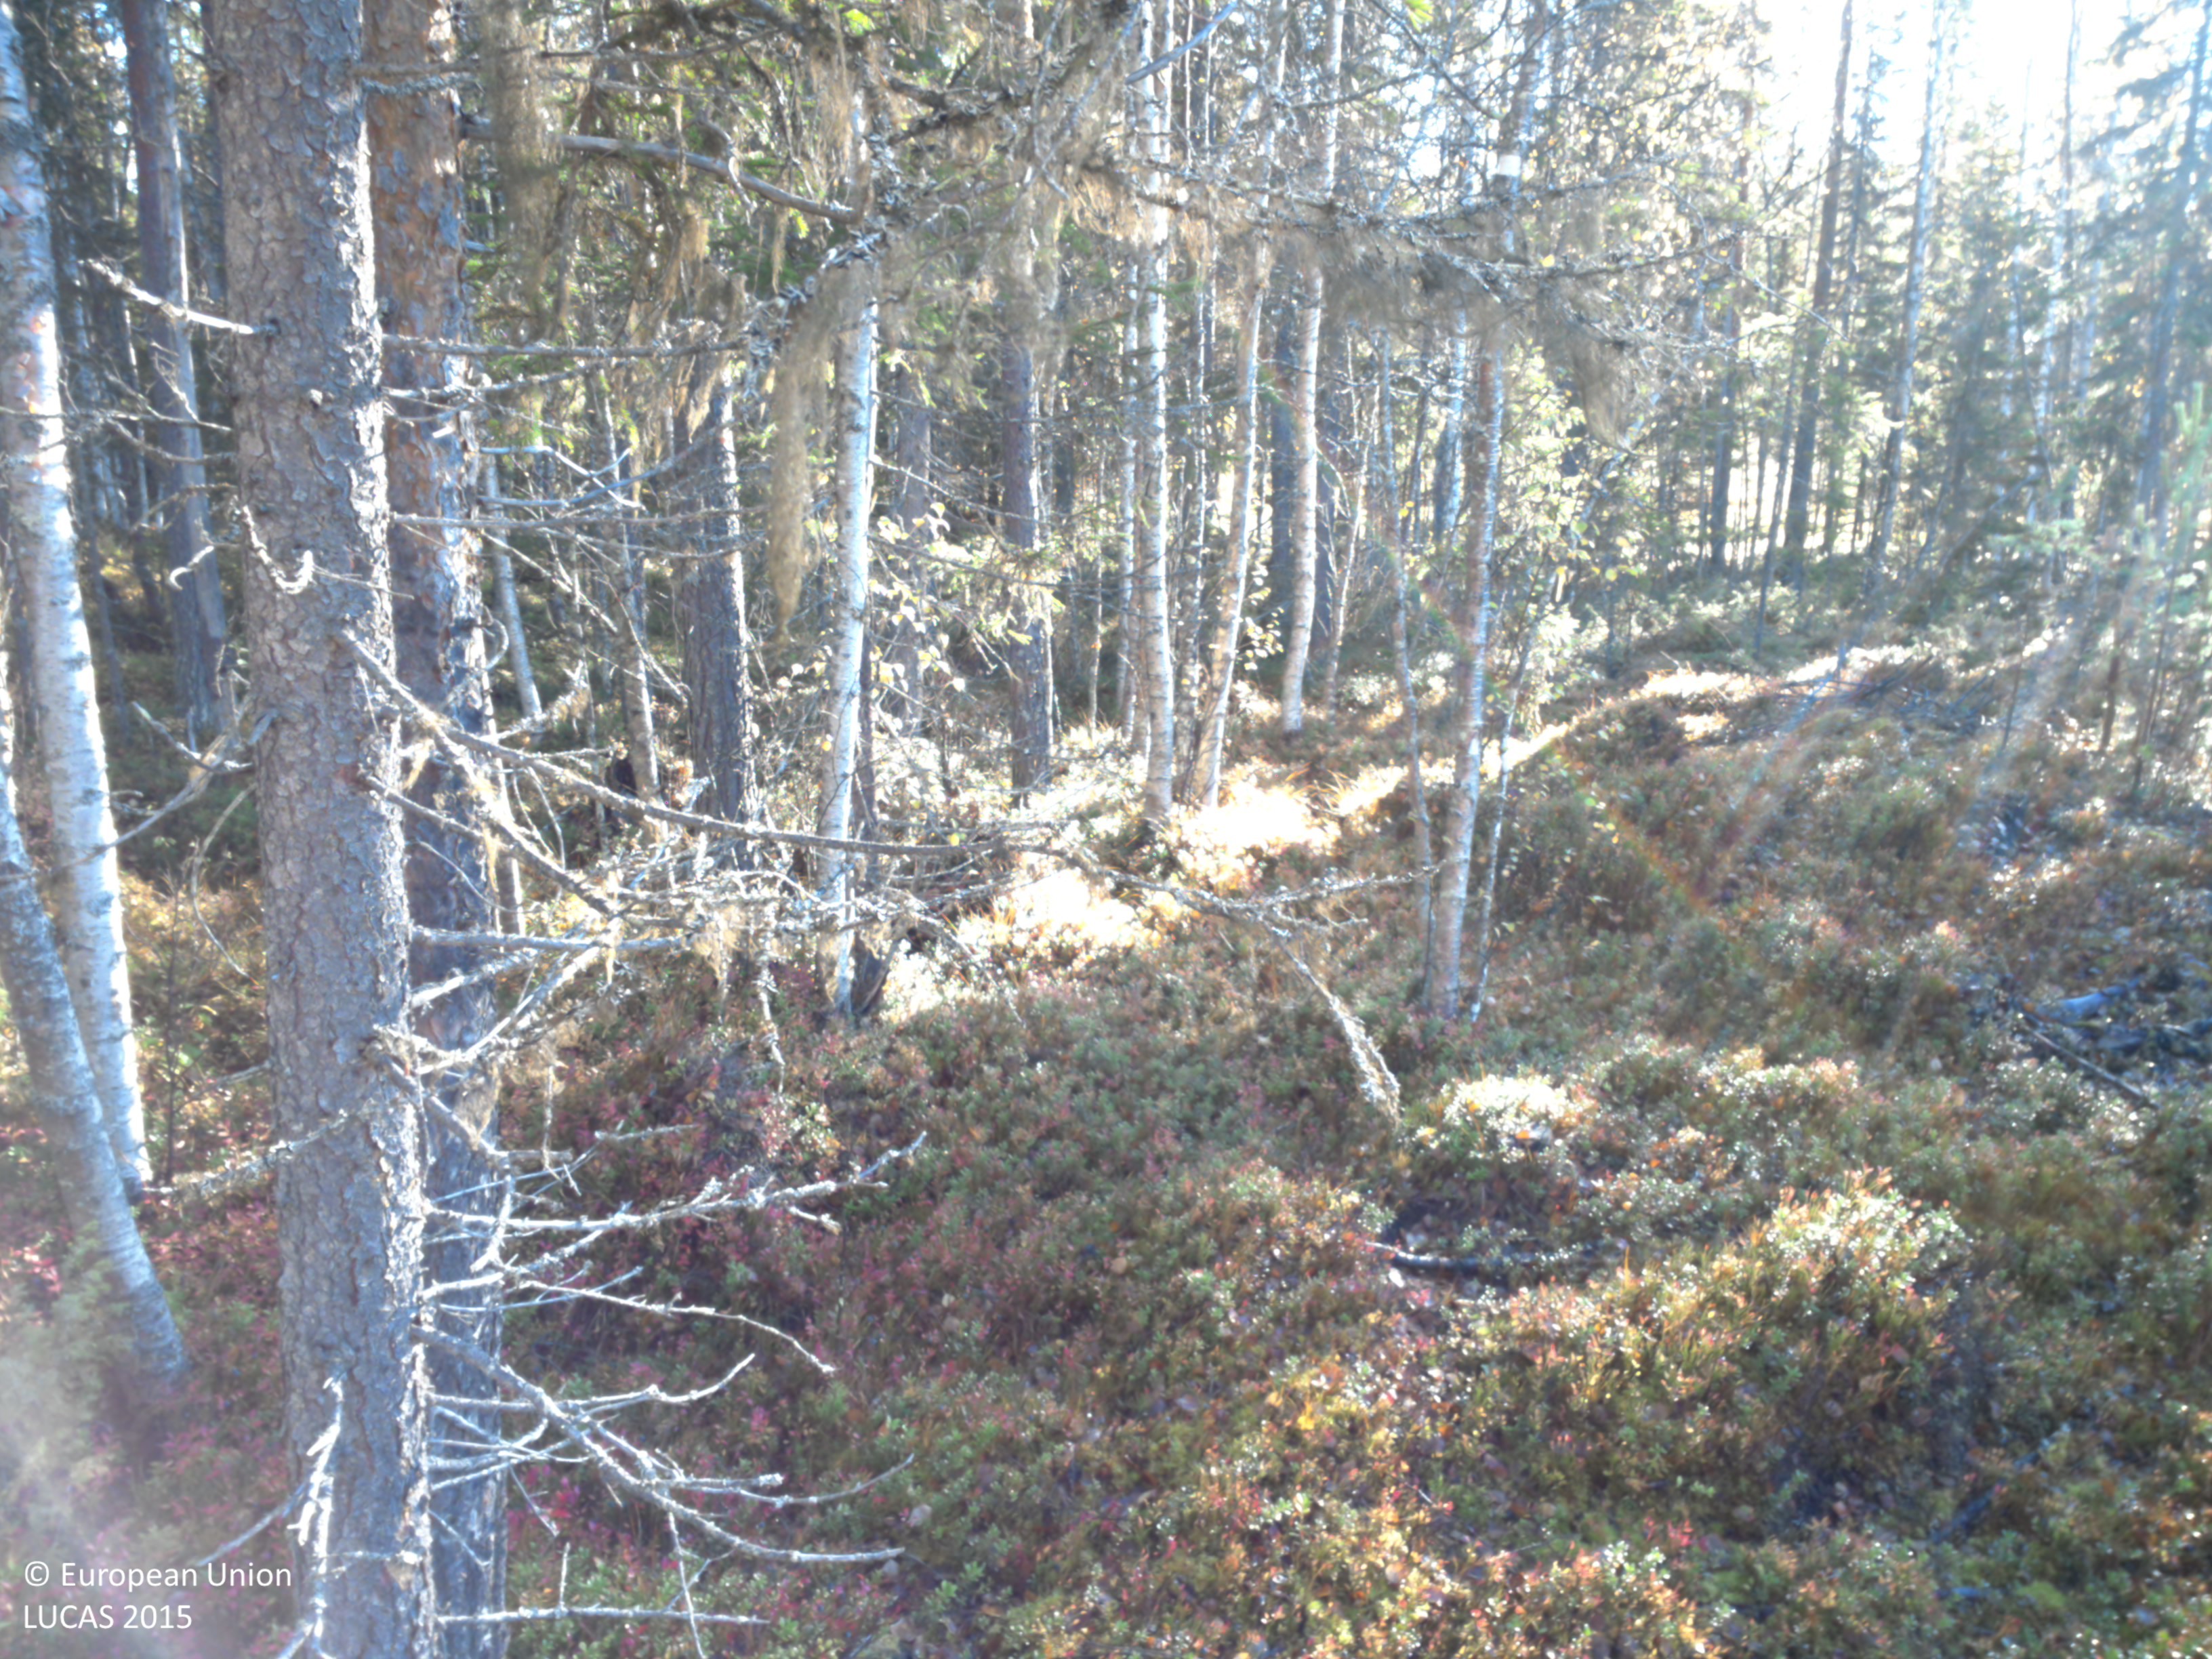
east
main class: Woodland
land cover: Pine dominated mixed woodland
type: boreal forest
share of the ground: > 75 %
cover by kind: coniferous forest trees 60 %, broadleaved forest trees 20 %, shrubs 15 %, lichens and mosses 5 %
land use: Forestry
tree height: > 5 m
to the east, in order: Pine dominated mixed woodland; Pine dominated coniferous woodland; Other coniferous woodland; Other mixed woodland
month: September
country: SE
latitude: 64.8156
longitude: 19.0024
